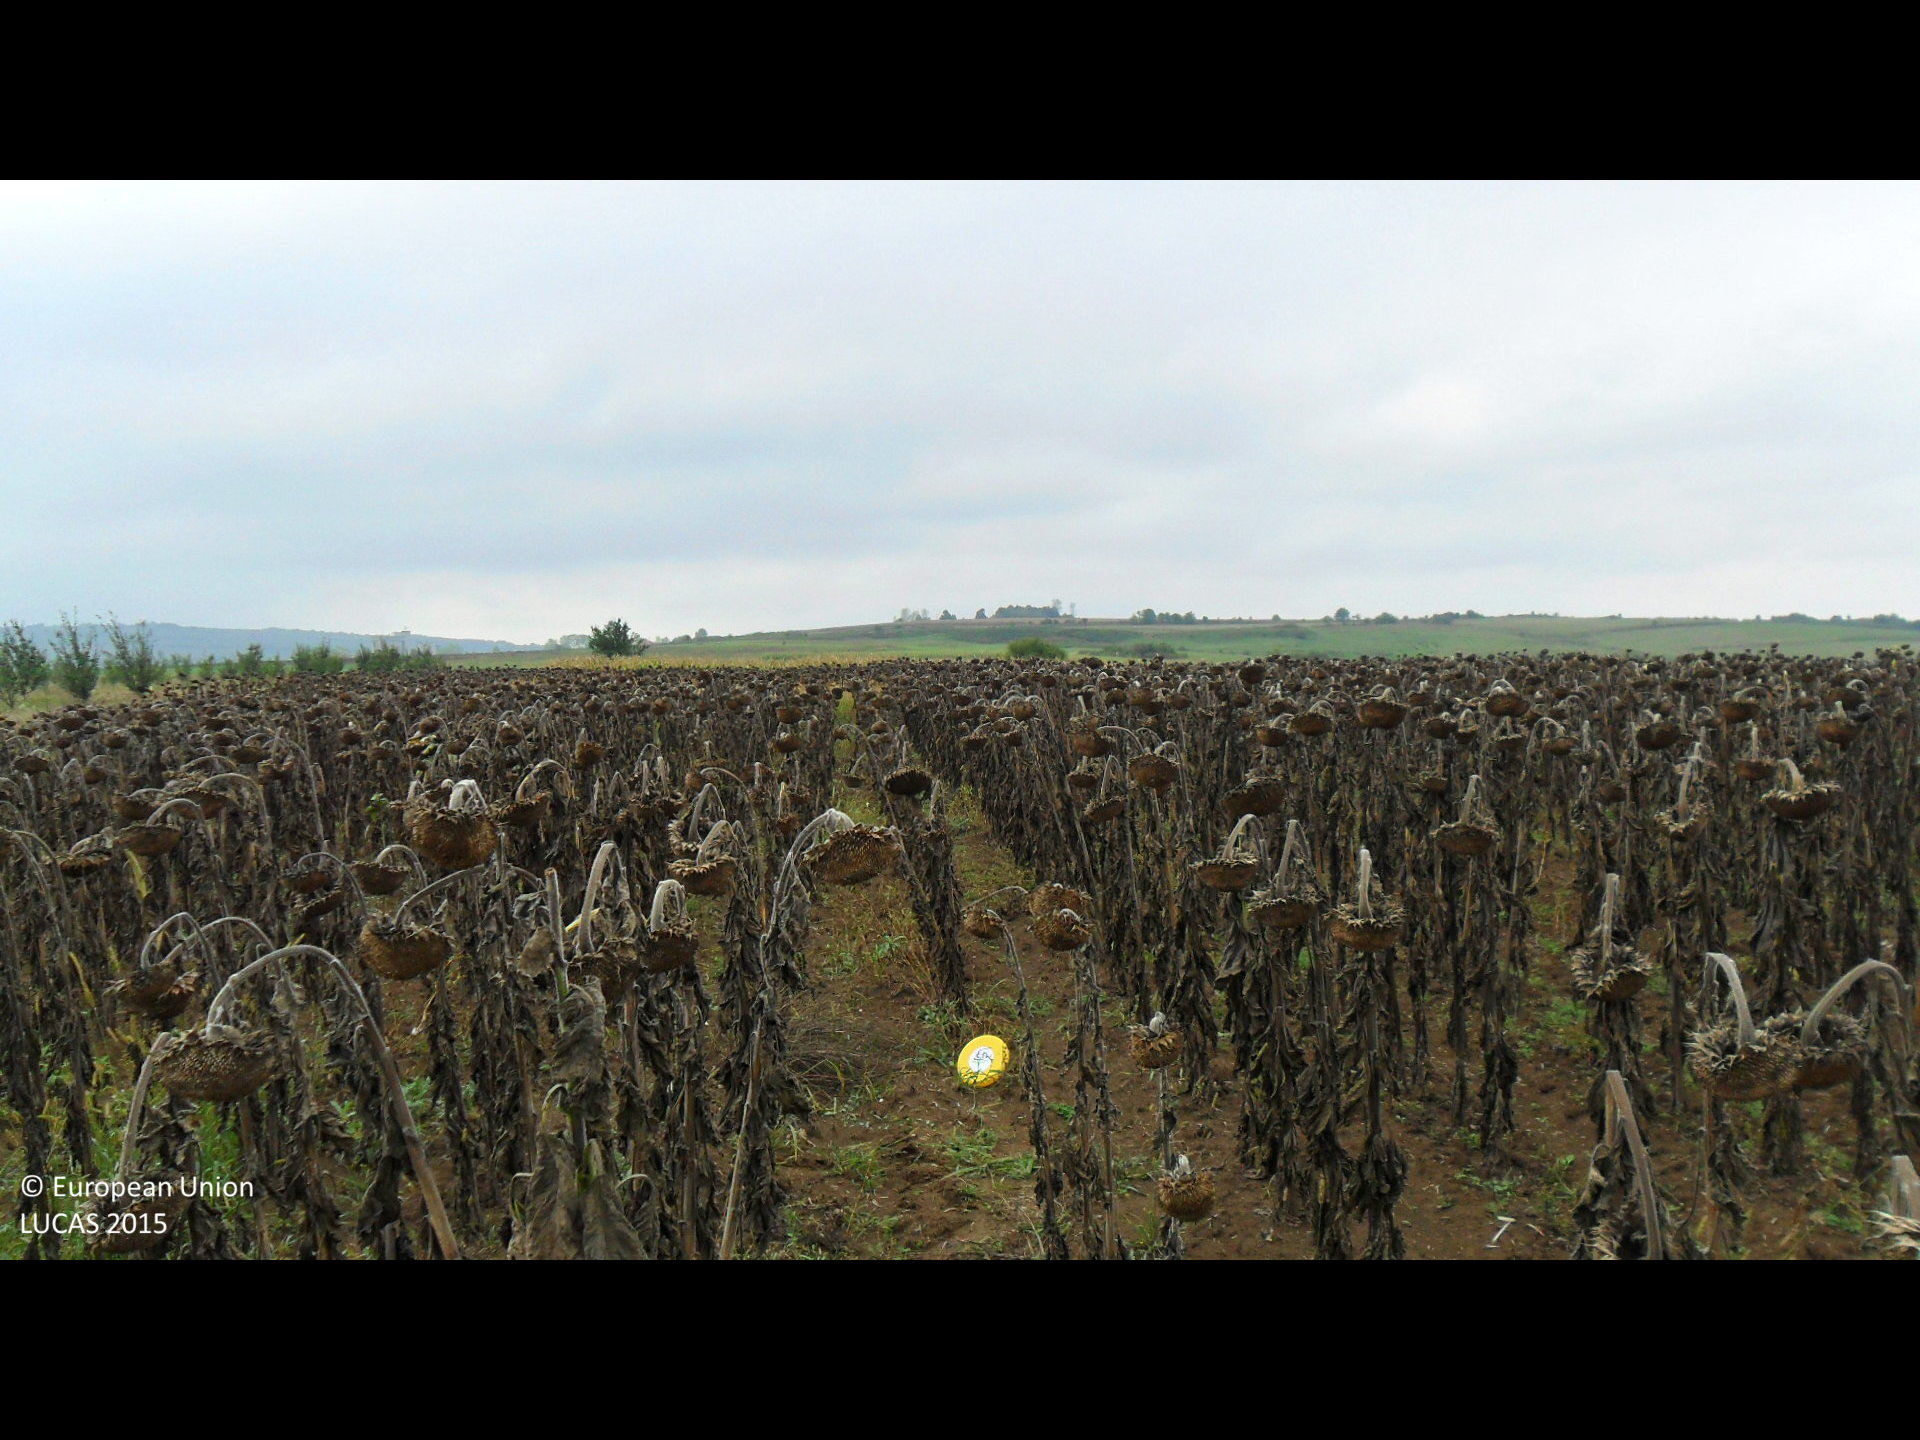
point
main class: Cropland
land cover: Sunflower
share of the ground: > 75 %
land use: Agriculture (excluding fallow land and kitchen gardens)
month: September
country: BG
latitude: 43.1195
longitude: 26.3319
